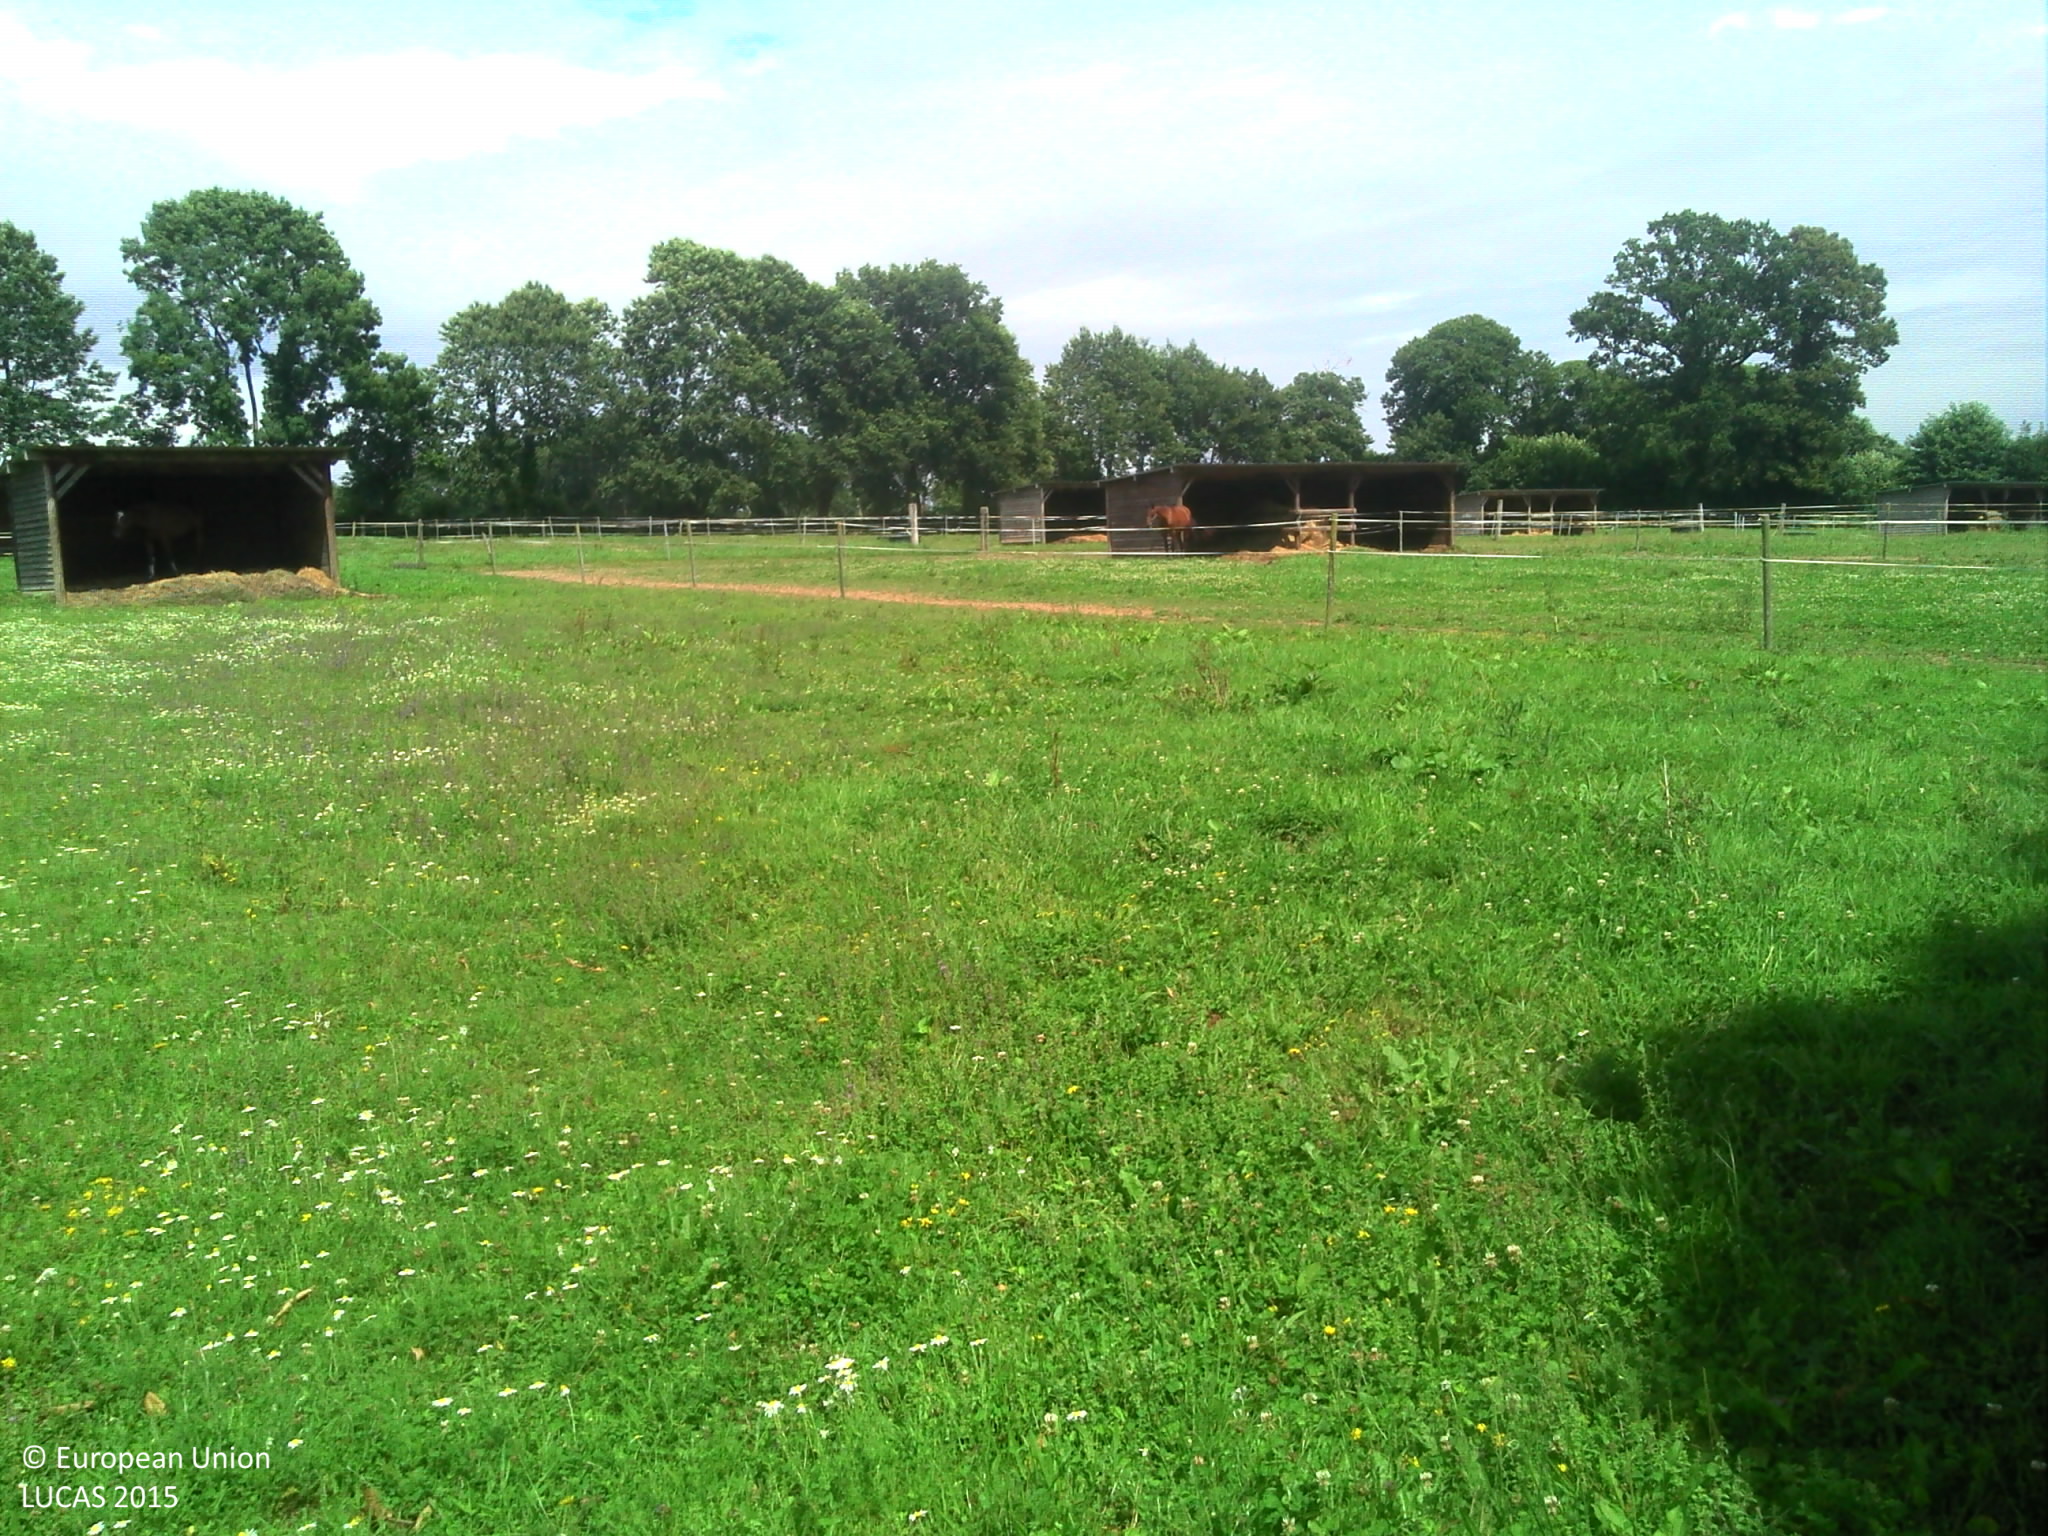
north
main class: Grassland
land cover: Grassland without tree/shrub cover
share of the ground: > 75 %
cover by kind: herbaceous plants 100 %
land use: Agriculture (excluding fallow land and kitchen gardens)
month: July
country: FR
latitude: 48.7794
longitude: -1.3548
